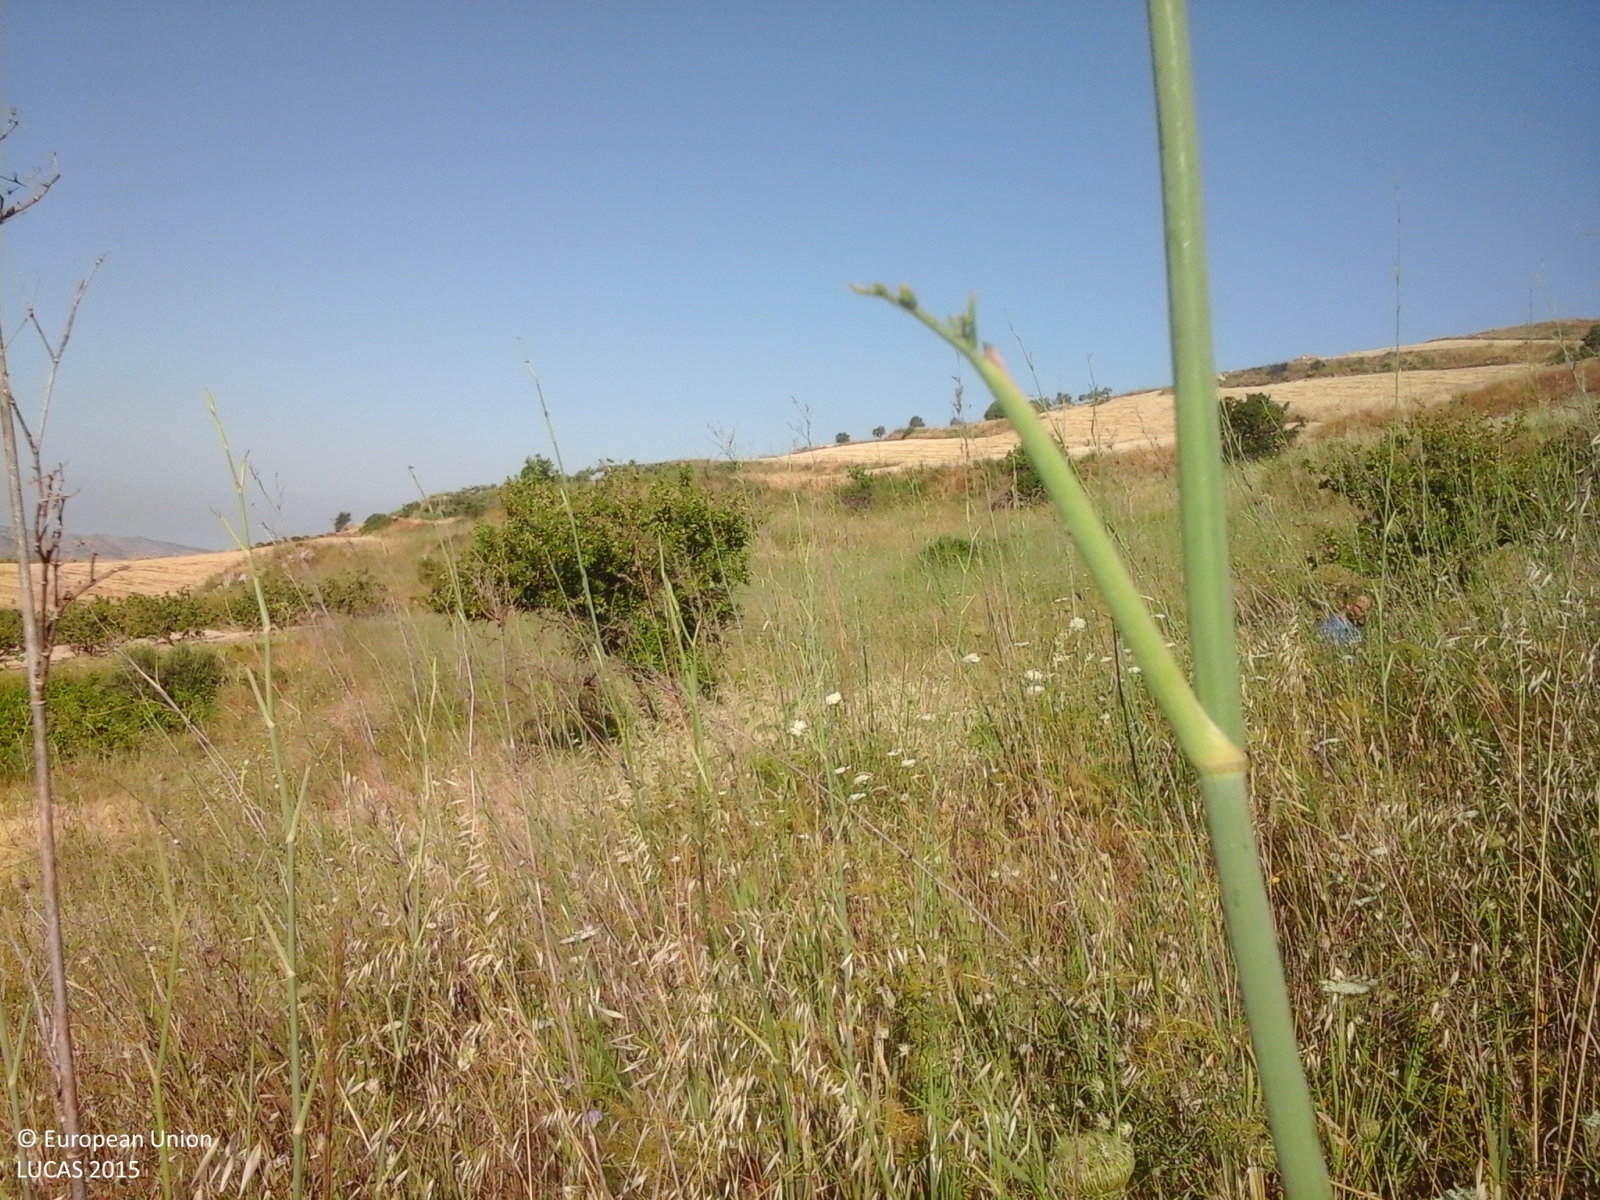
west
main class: Grassland
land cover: Spontaneously vegetated surfaces
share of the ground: > 75 %
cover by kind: herbaceous plants 100 %
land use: Abandoned areas
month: July
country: IT
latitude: 37.5174
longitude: 13.5596
